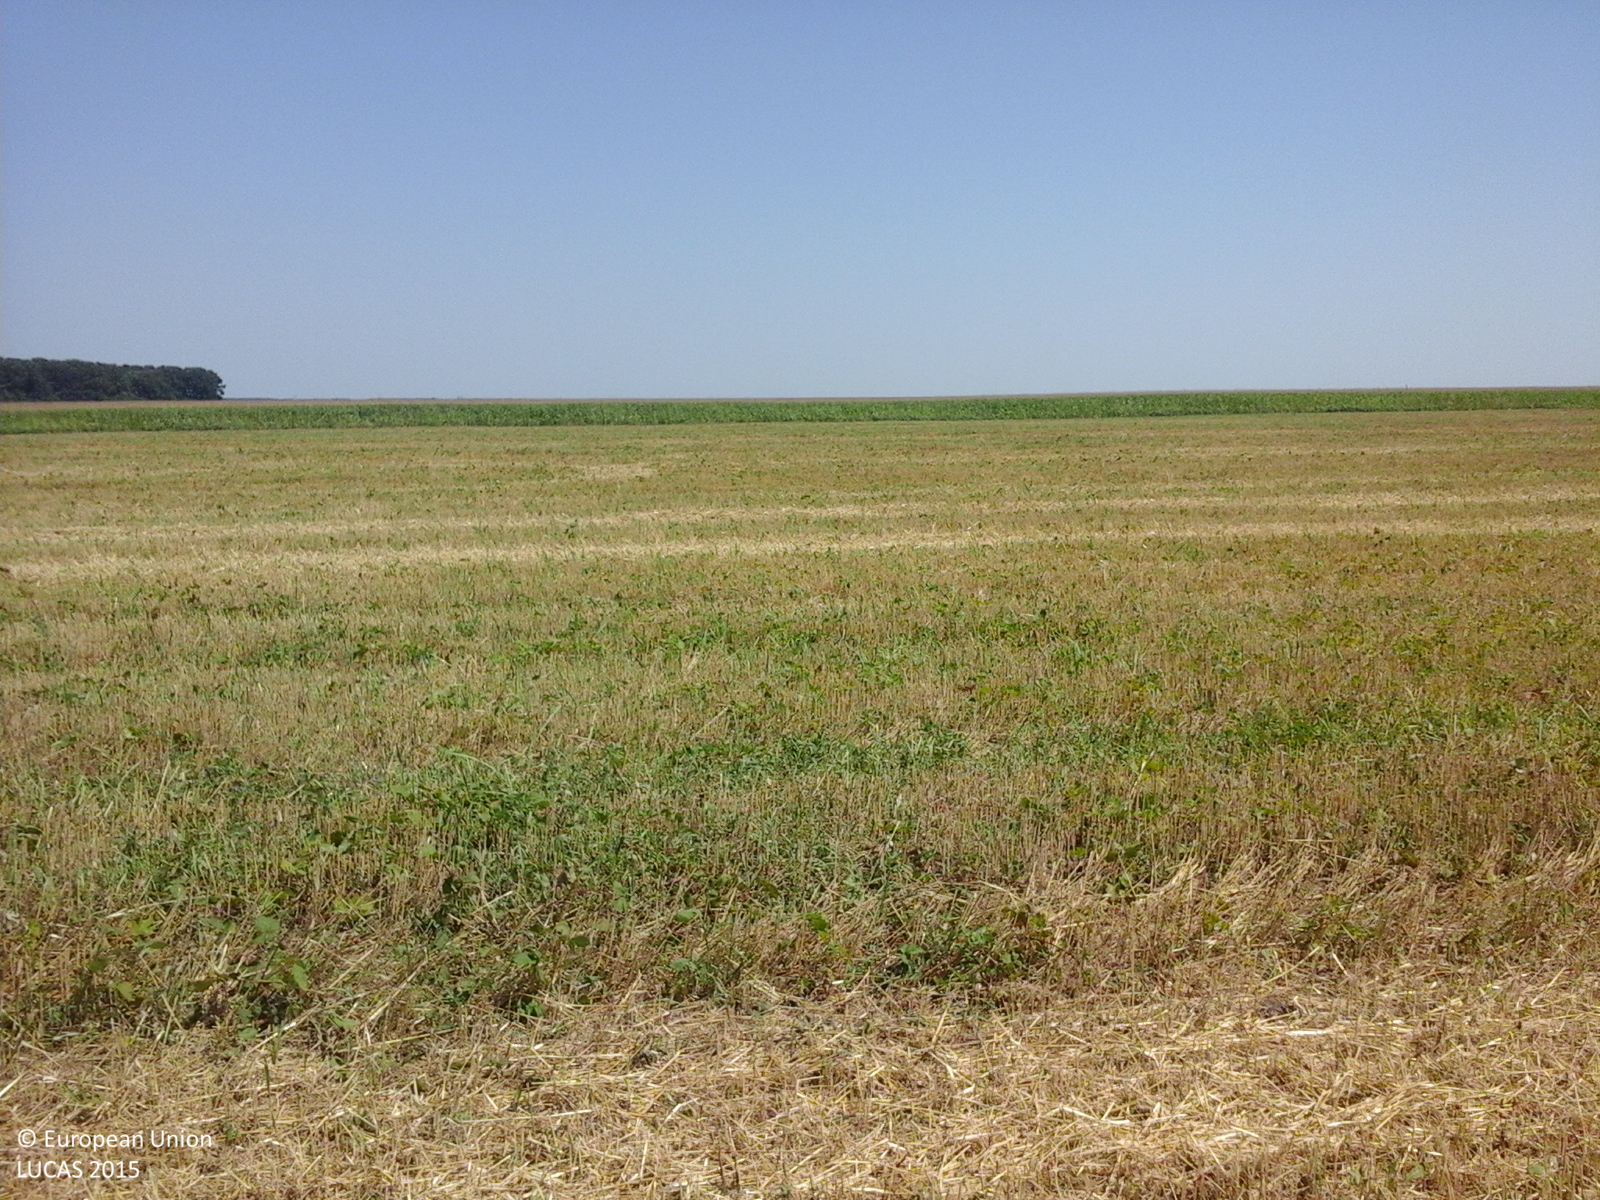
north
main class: Cropland
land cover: Common wheat
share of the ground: < 10 %
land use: Agriculture (excluding fallow land and kitchen gardens)
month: July
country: RO
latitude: 44.4051
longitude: 26.4496
